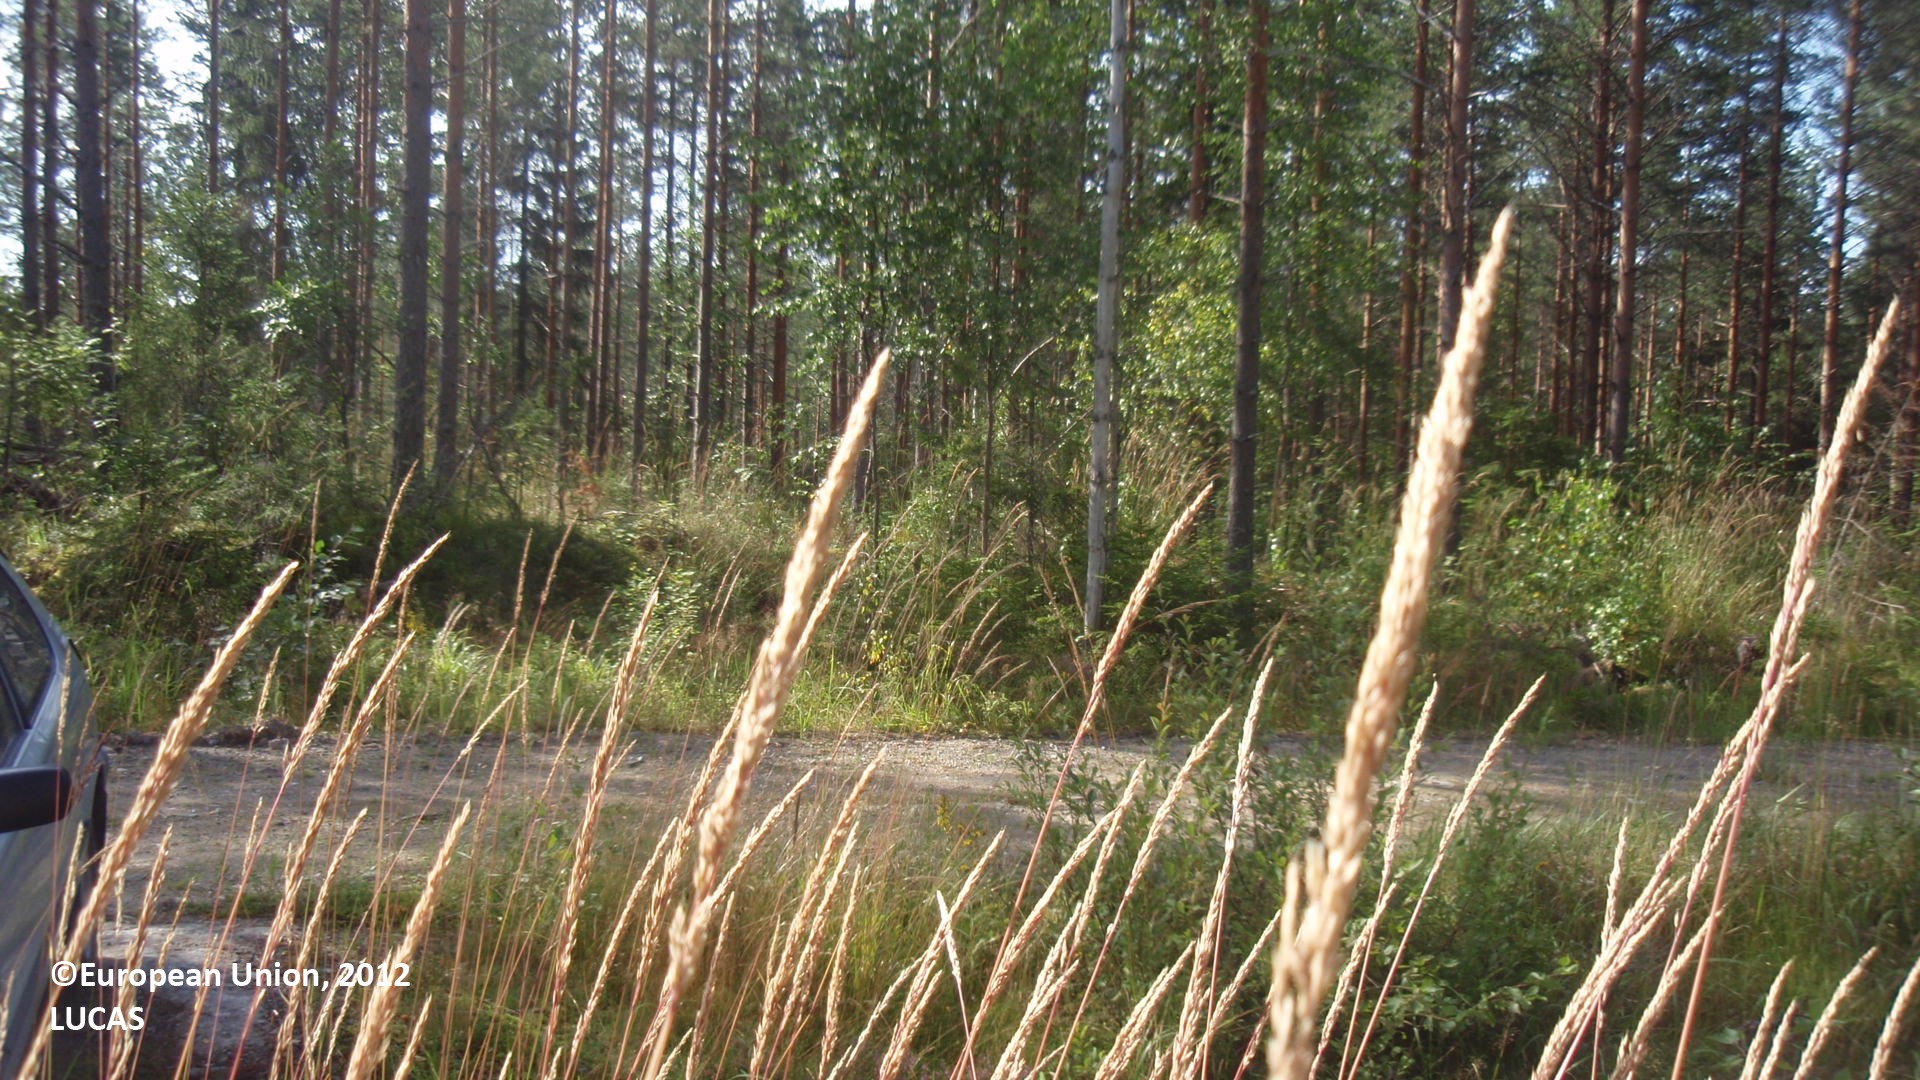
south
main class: Woodland
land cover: Pine dominated coniferous woodland
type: boreal forest
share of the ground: 50 - 75 %
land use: Forestry
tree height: > 5 m
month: August
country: FI
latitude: 61.3635
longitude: 27.2485
